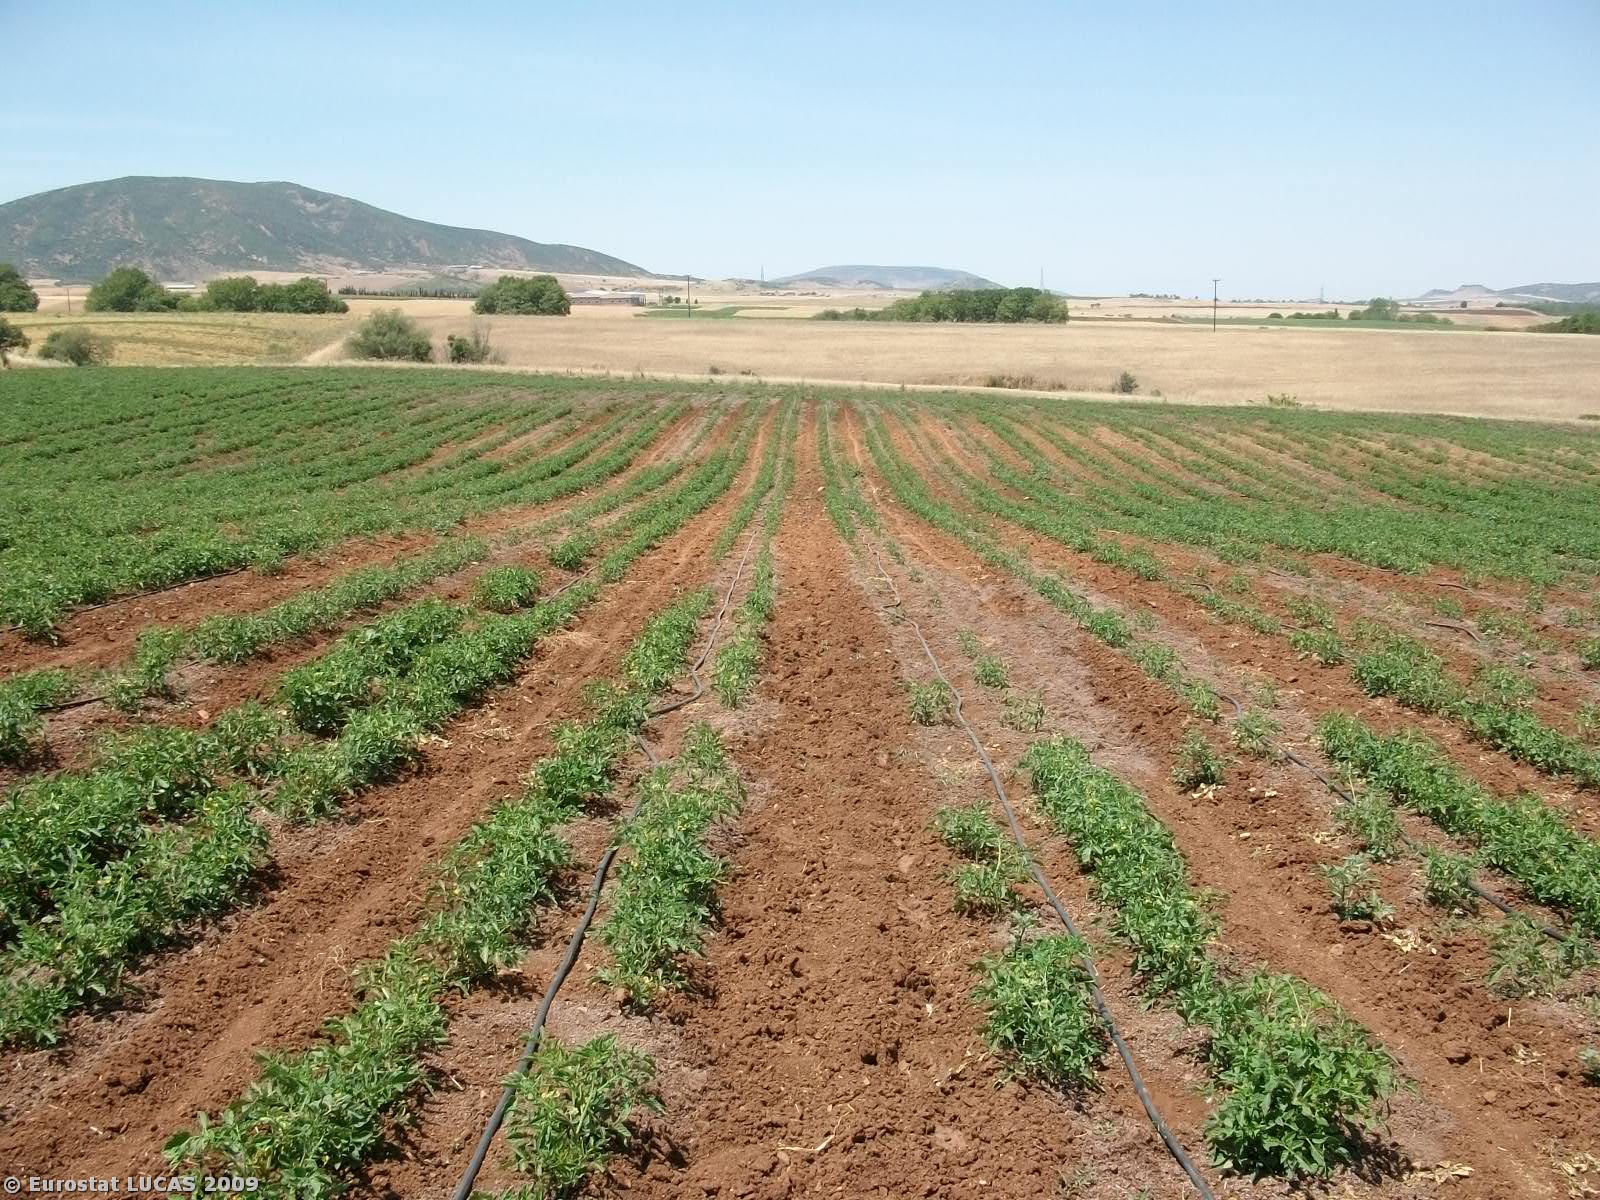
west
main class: Cropland
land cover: Tomatoes
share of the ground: 25 - 50 %
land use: Agriculture (excluding fallow land and kitchen gardens)
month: May
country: GR
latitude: 39.2495
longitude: 22.4651
